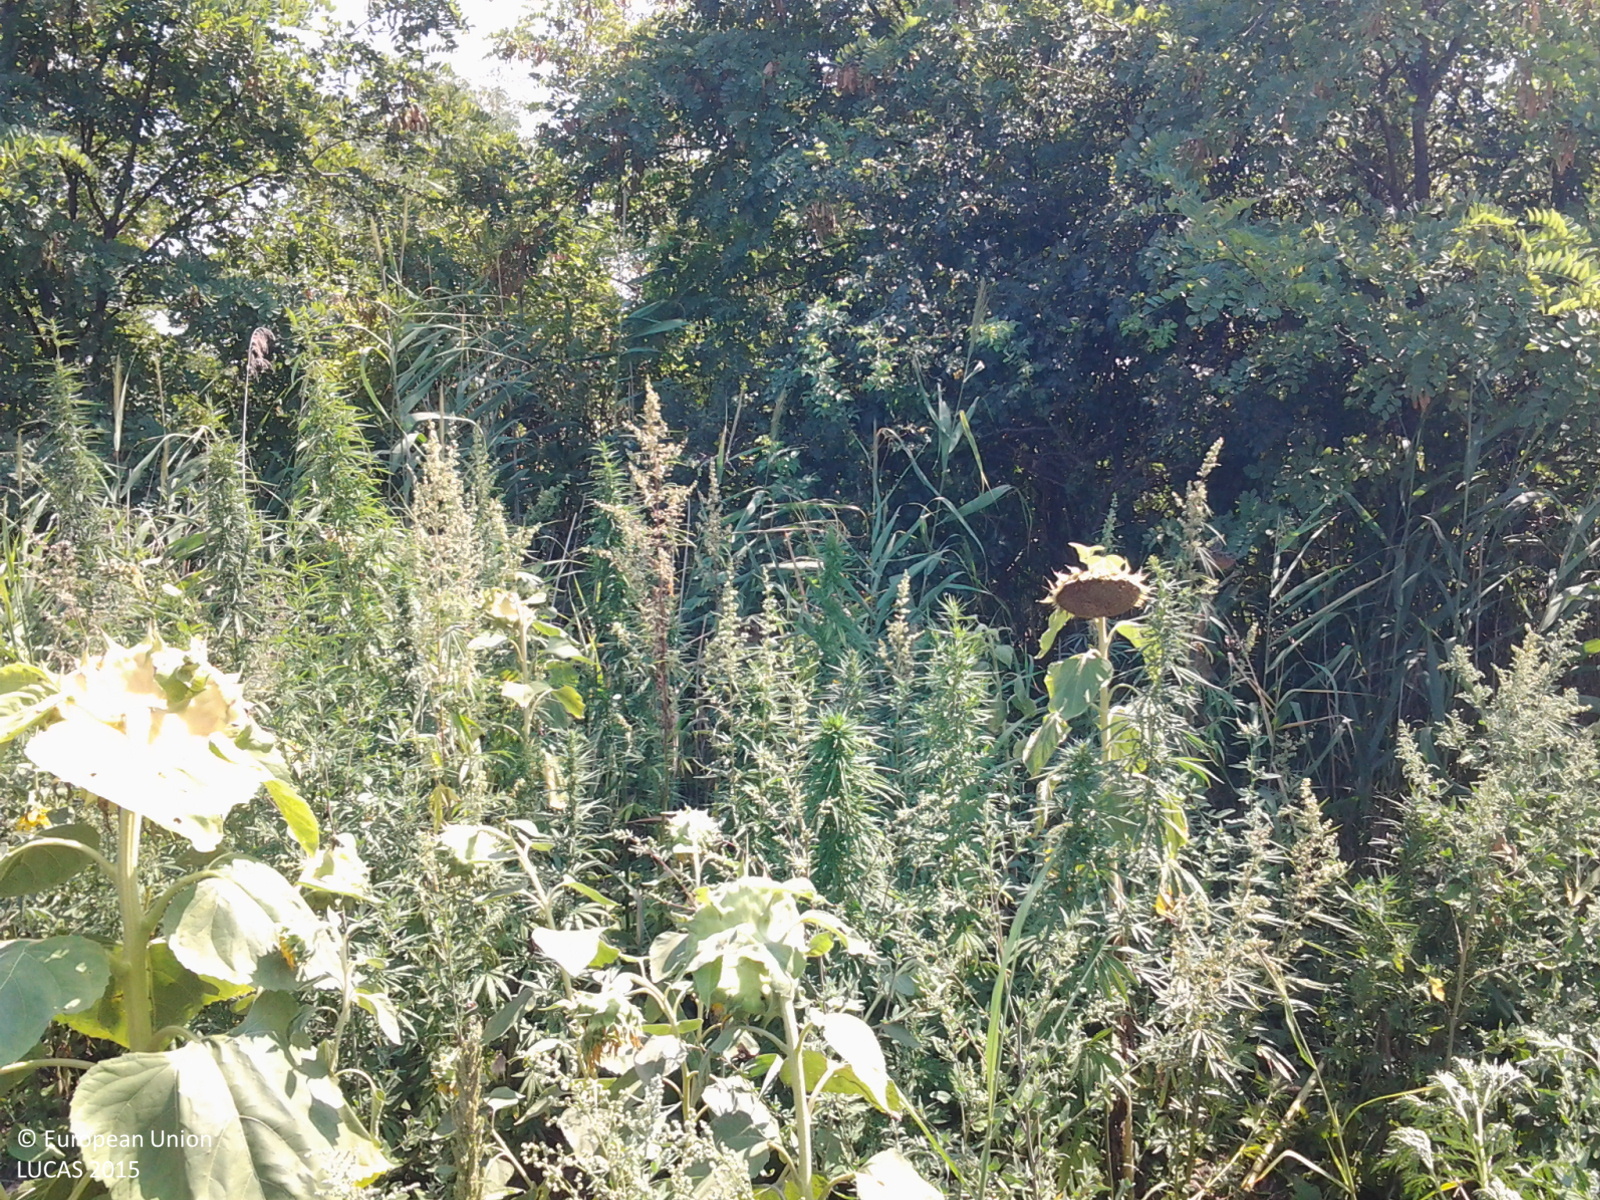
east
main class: Cropland
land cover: Sunflower
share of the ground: > 75 %
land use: Agriculture (excluding fallow land and kitchen gardens)
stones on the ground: < 10 %
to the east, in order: Sunflower; Shruby margins; Lines of trees; Tracks; Lines of trees; Shruby margins; Maize; Spontaneously vegetated surfaces; Maize; Grass margins; Tracks; Grass margins; Shrubland with sparse tree cover; Common wheat
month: August
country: HU
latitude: 47.2516
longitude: 19.8942
